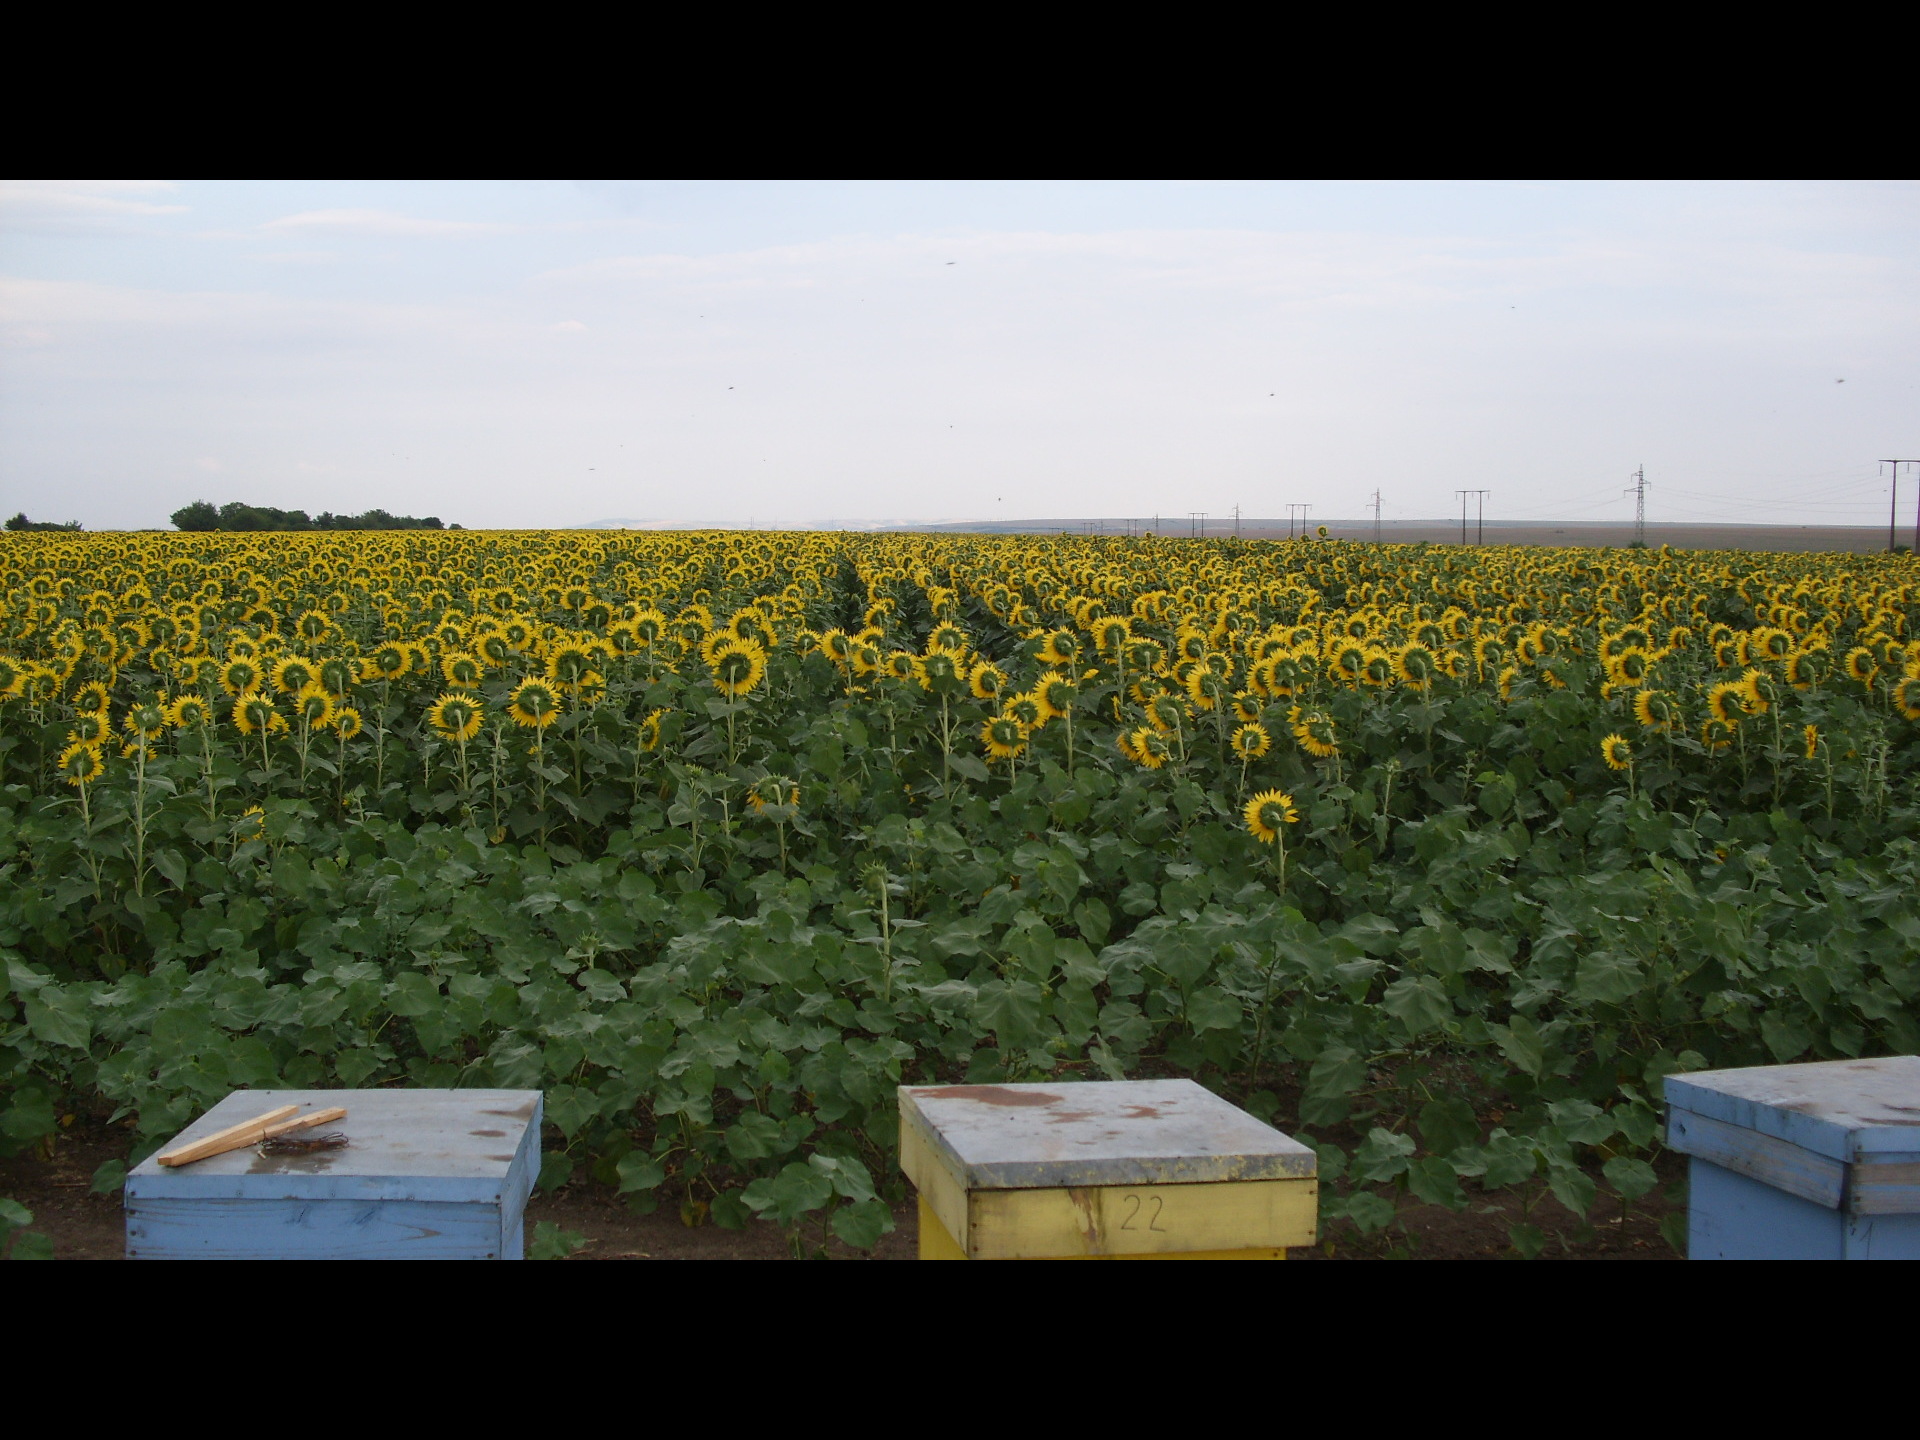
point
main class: Cropland
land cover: Sunflower
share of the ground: > 75 %
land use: Agriculture (excluding fallow land and kitchen gardens)
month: July
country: BG
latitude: 43.7820
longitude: 23.5798
